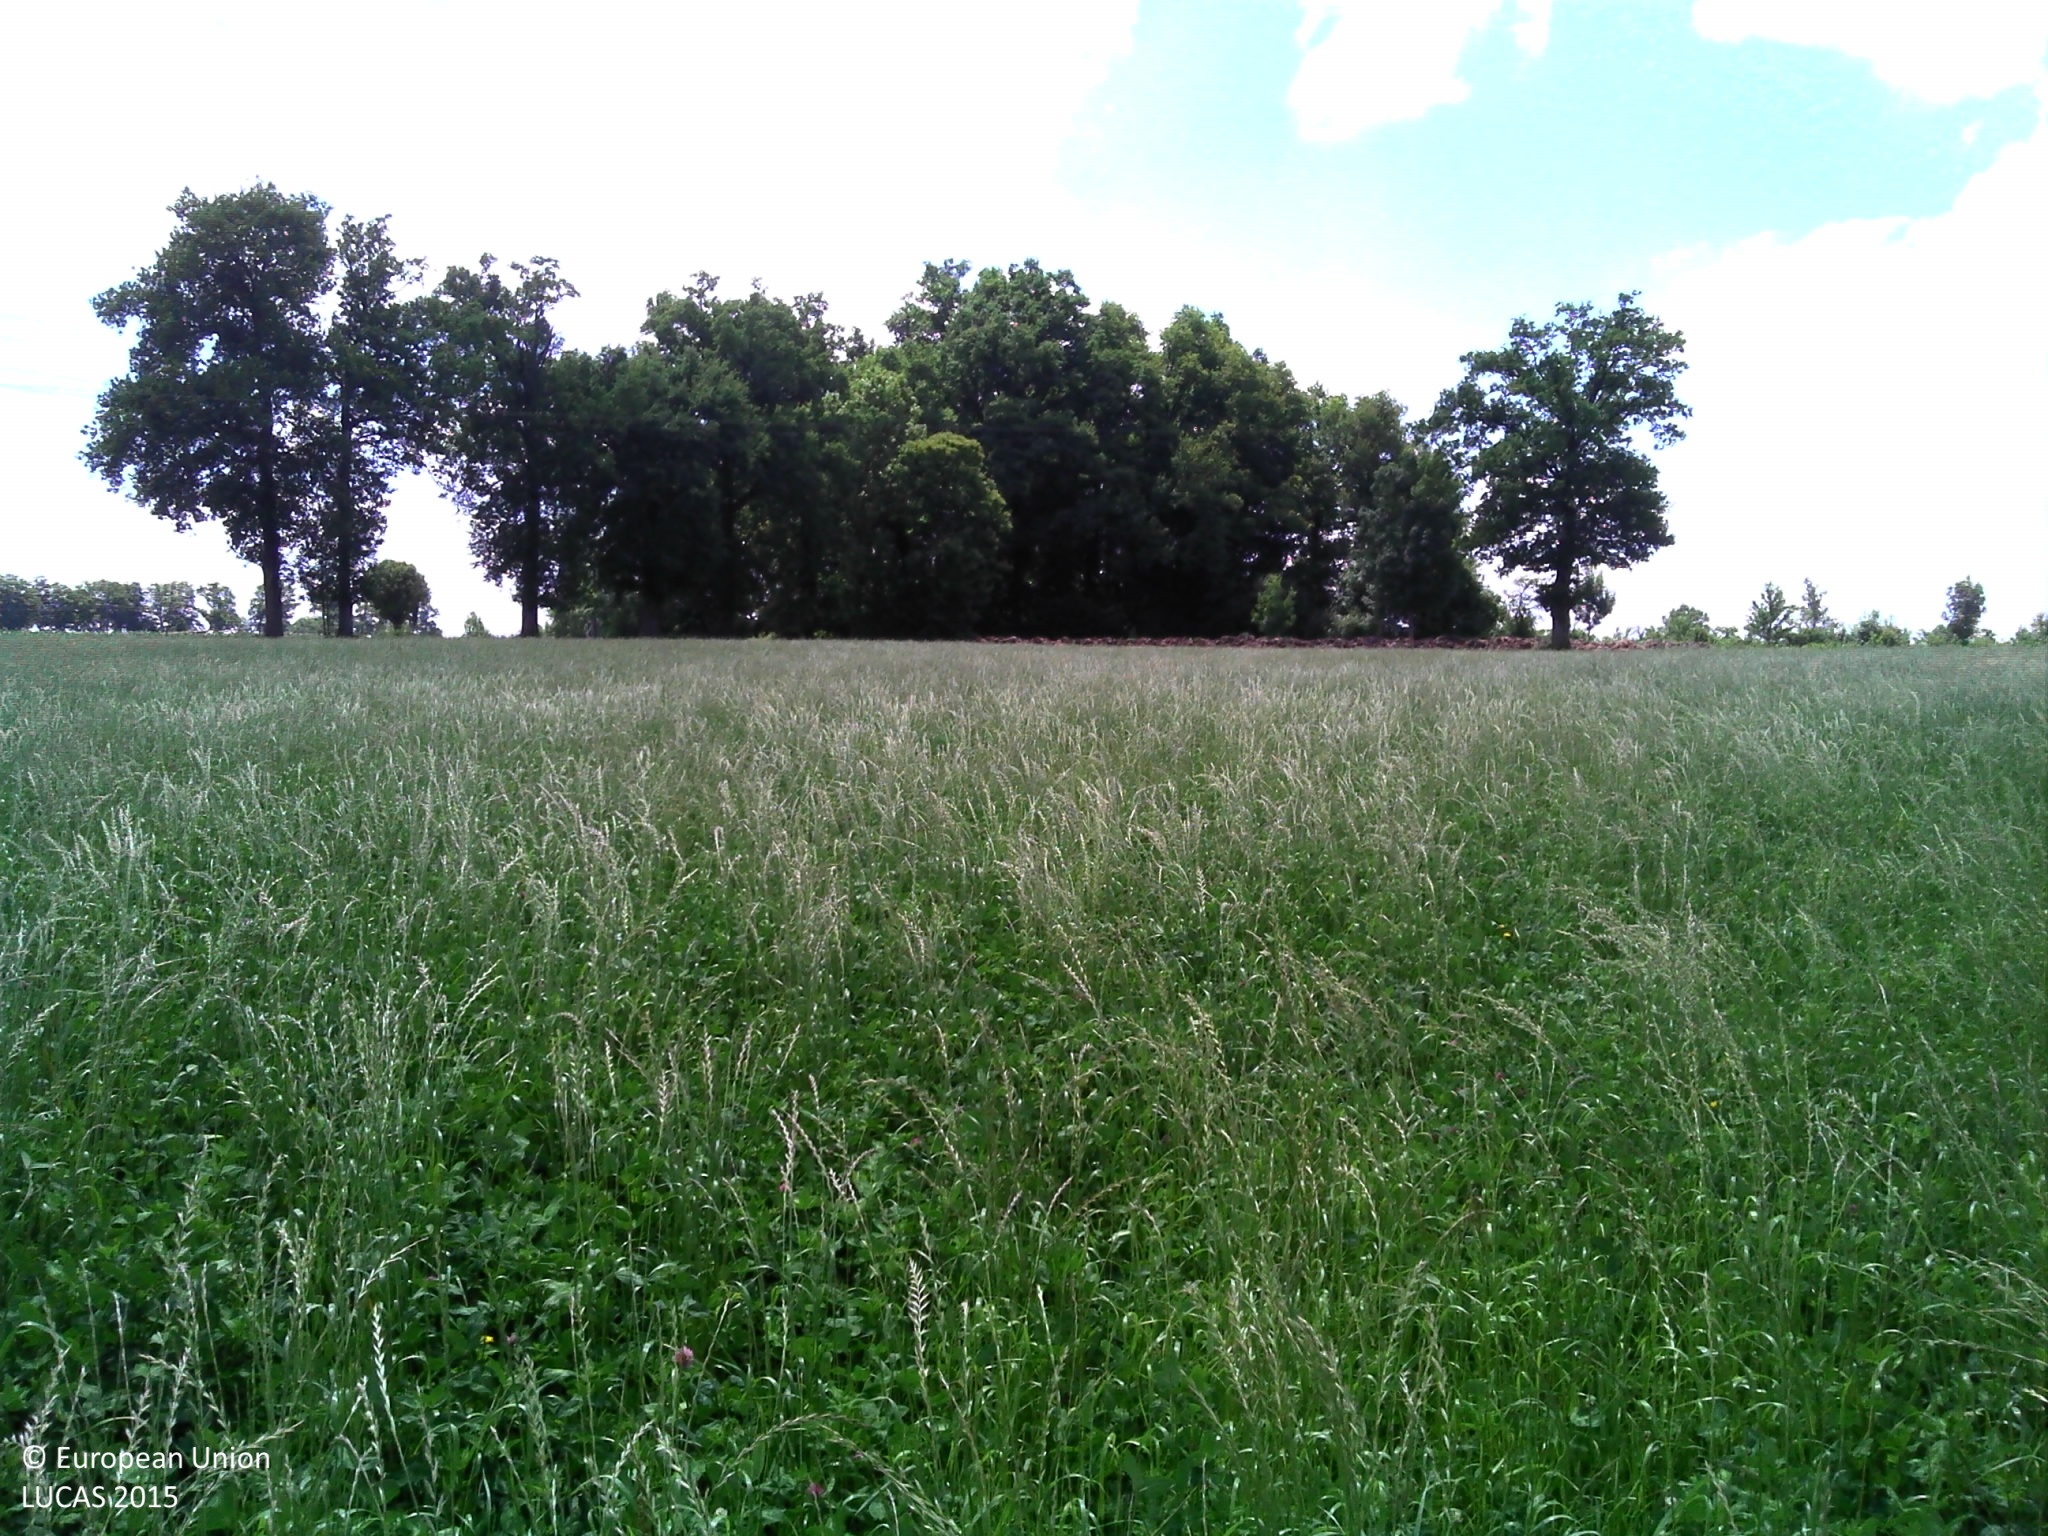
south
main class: Cropland
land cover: Temporary grasslands
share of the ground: > 75 %
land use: Agriculture (excluding fallow land and kitchen gardens)
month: June
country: FR
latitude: 45.9775
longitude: 0.6541
